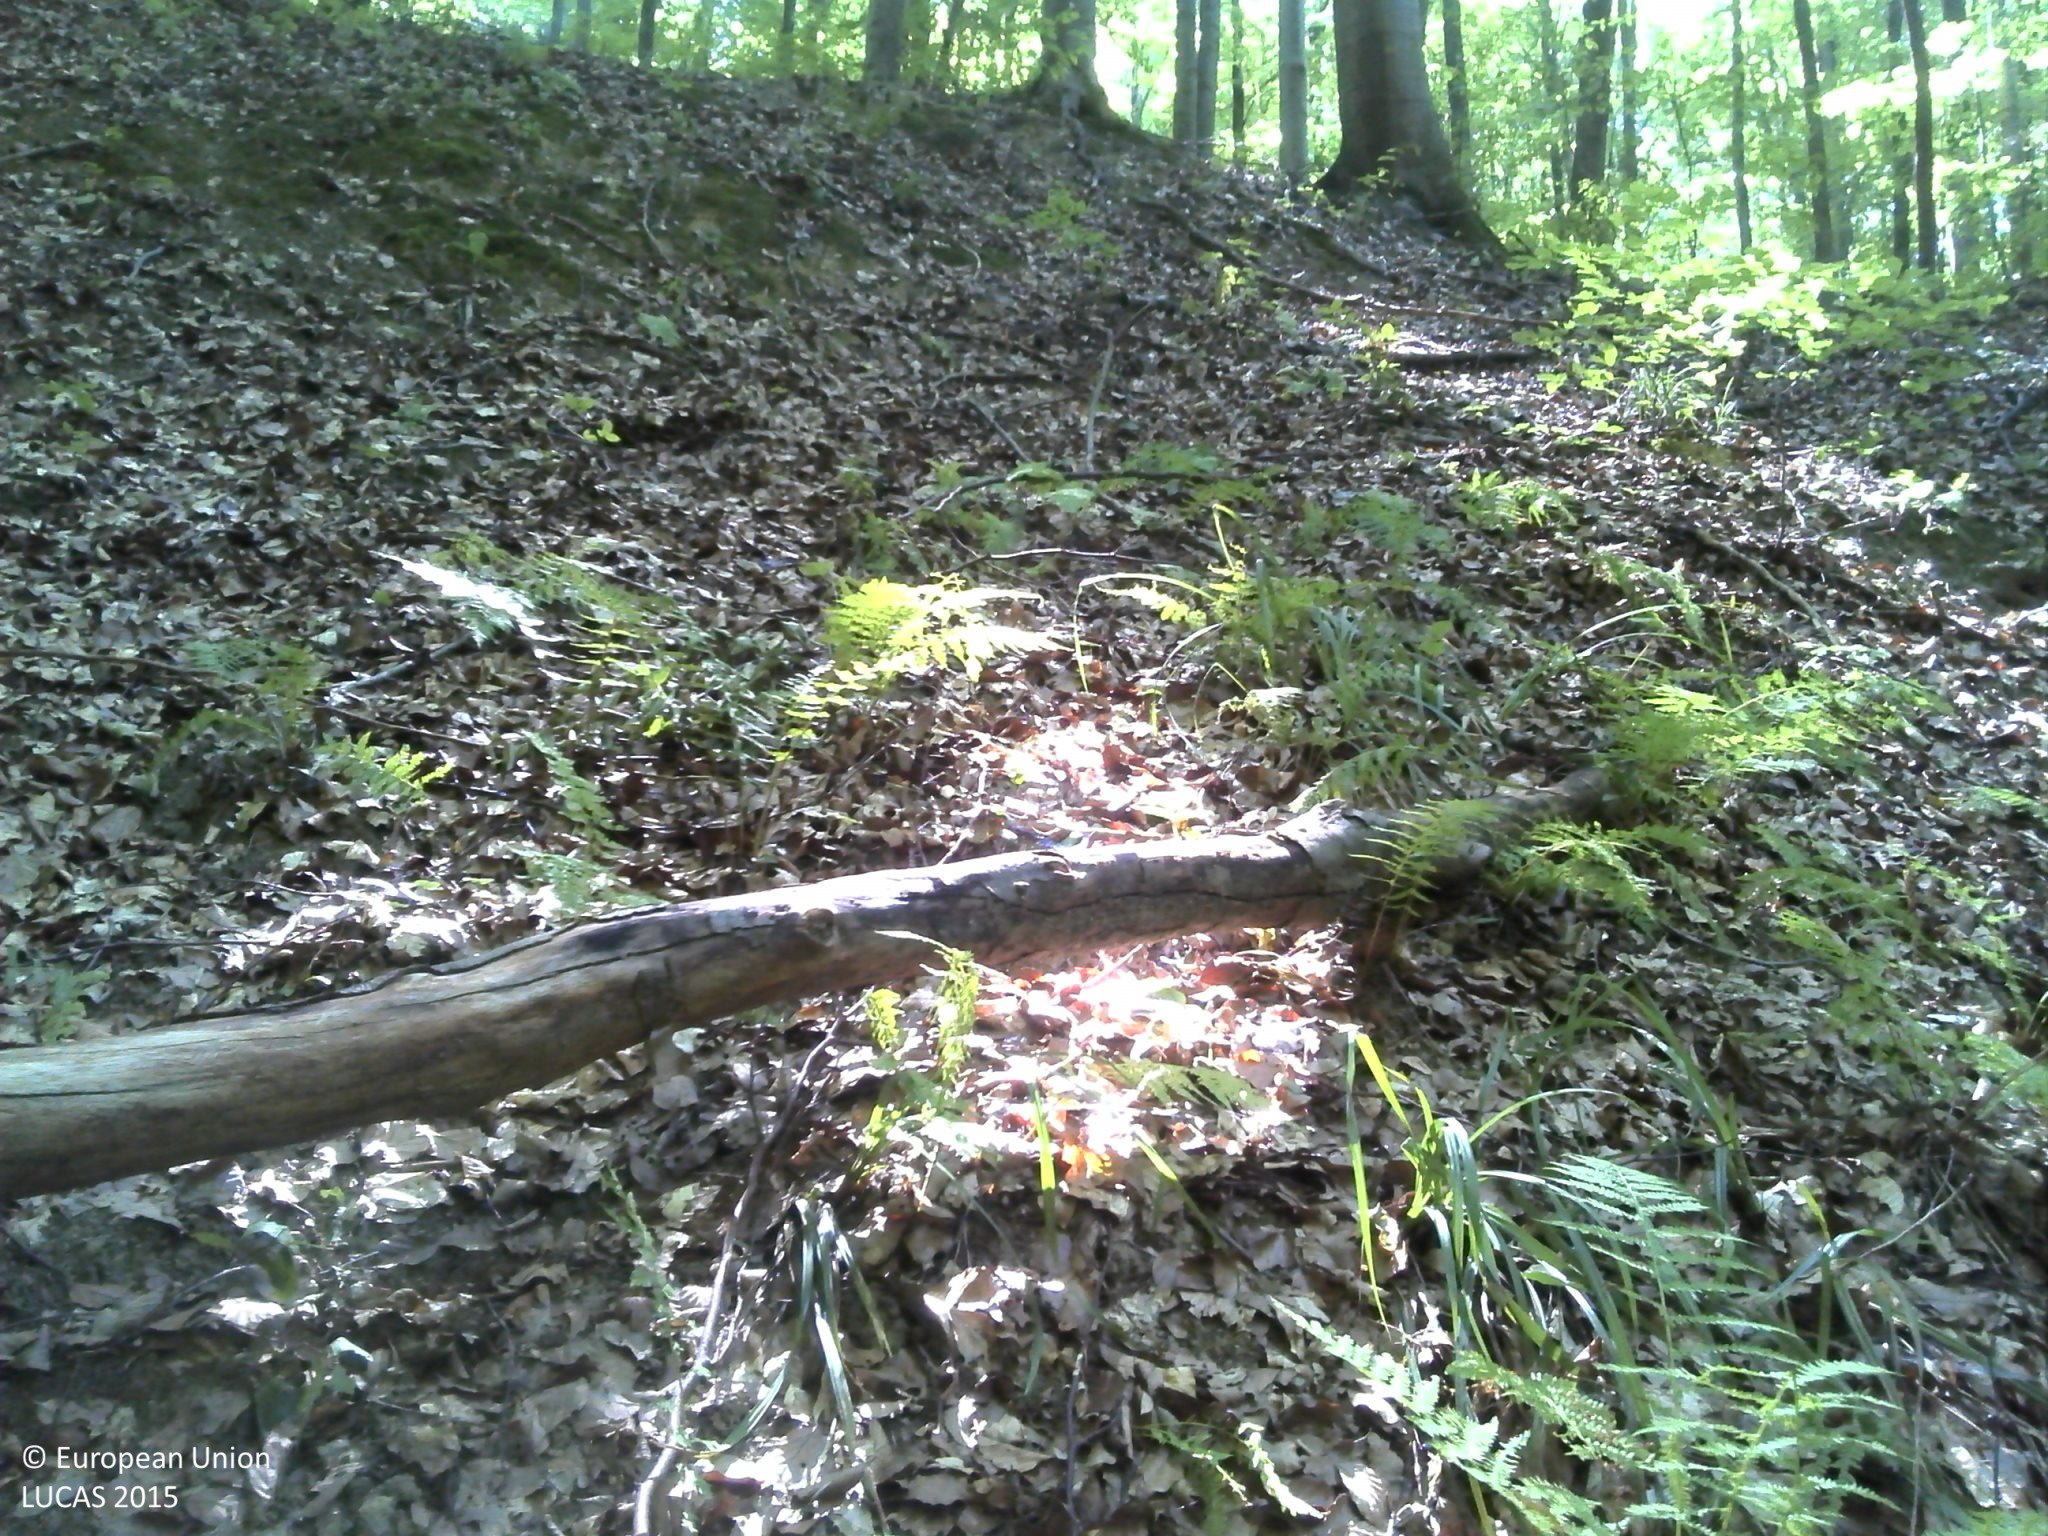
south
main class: Woodland
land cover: Broadleaved woodland
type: beech forest
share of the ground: > 75 %
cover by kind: broadleaved forest trees 100 %
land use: Forestry
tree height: > 5 m
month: August
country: HR
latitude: 45.3034
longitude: 17.5894
